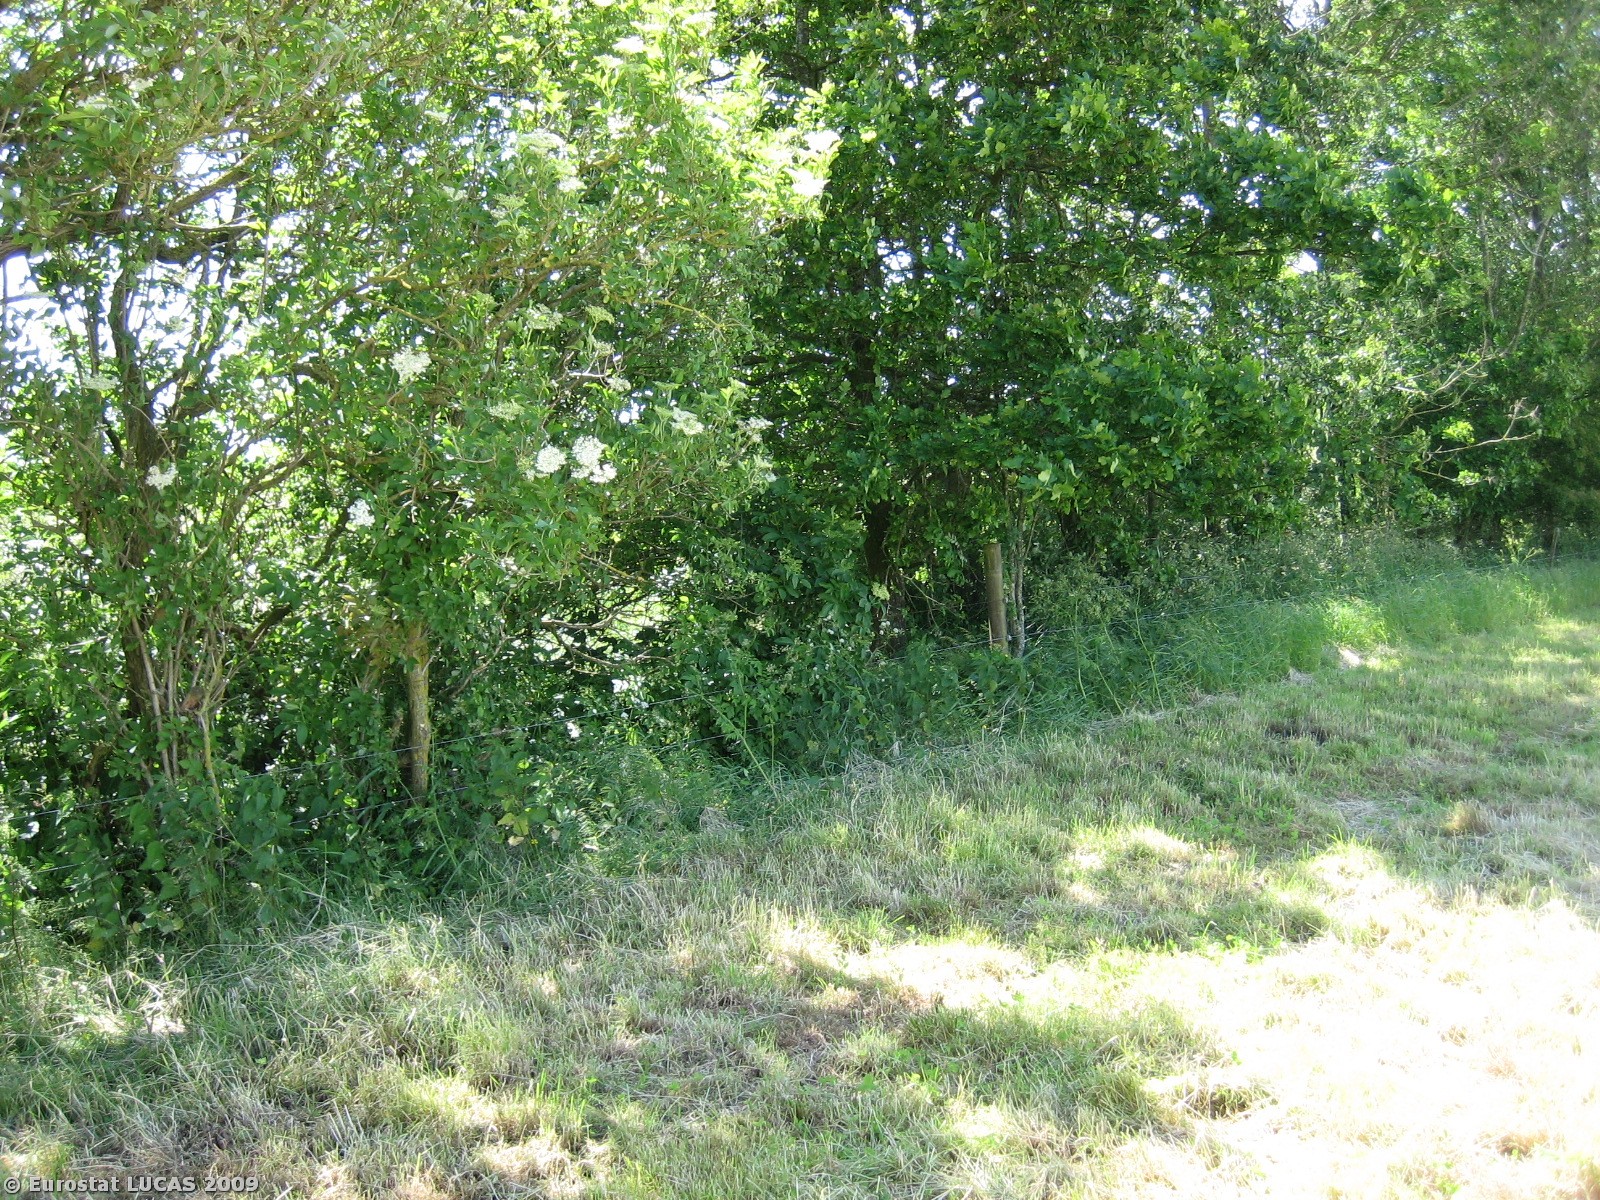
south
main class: Cropland
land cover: Temporary grasslands
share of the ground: > 75 %
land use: Agriculture (excluding fallow land and kitchen gardens)
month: June
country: DK
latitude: 55.5927
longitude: 9.3183
